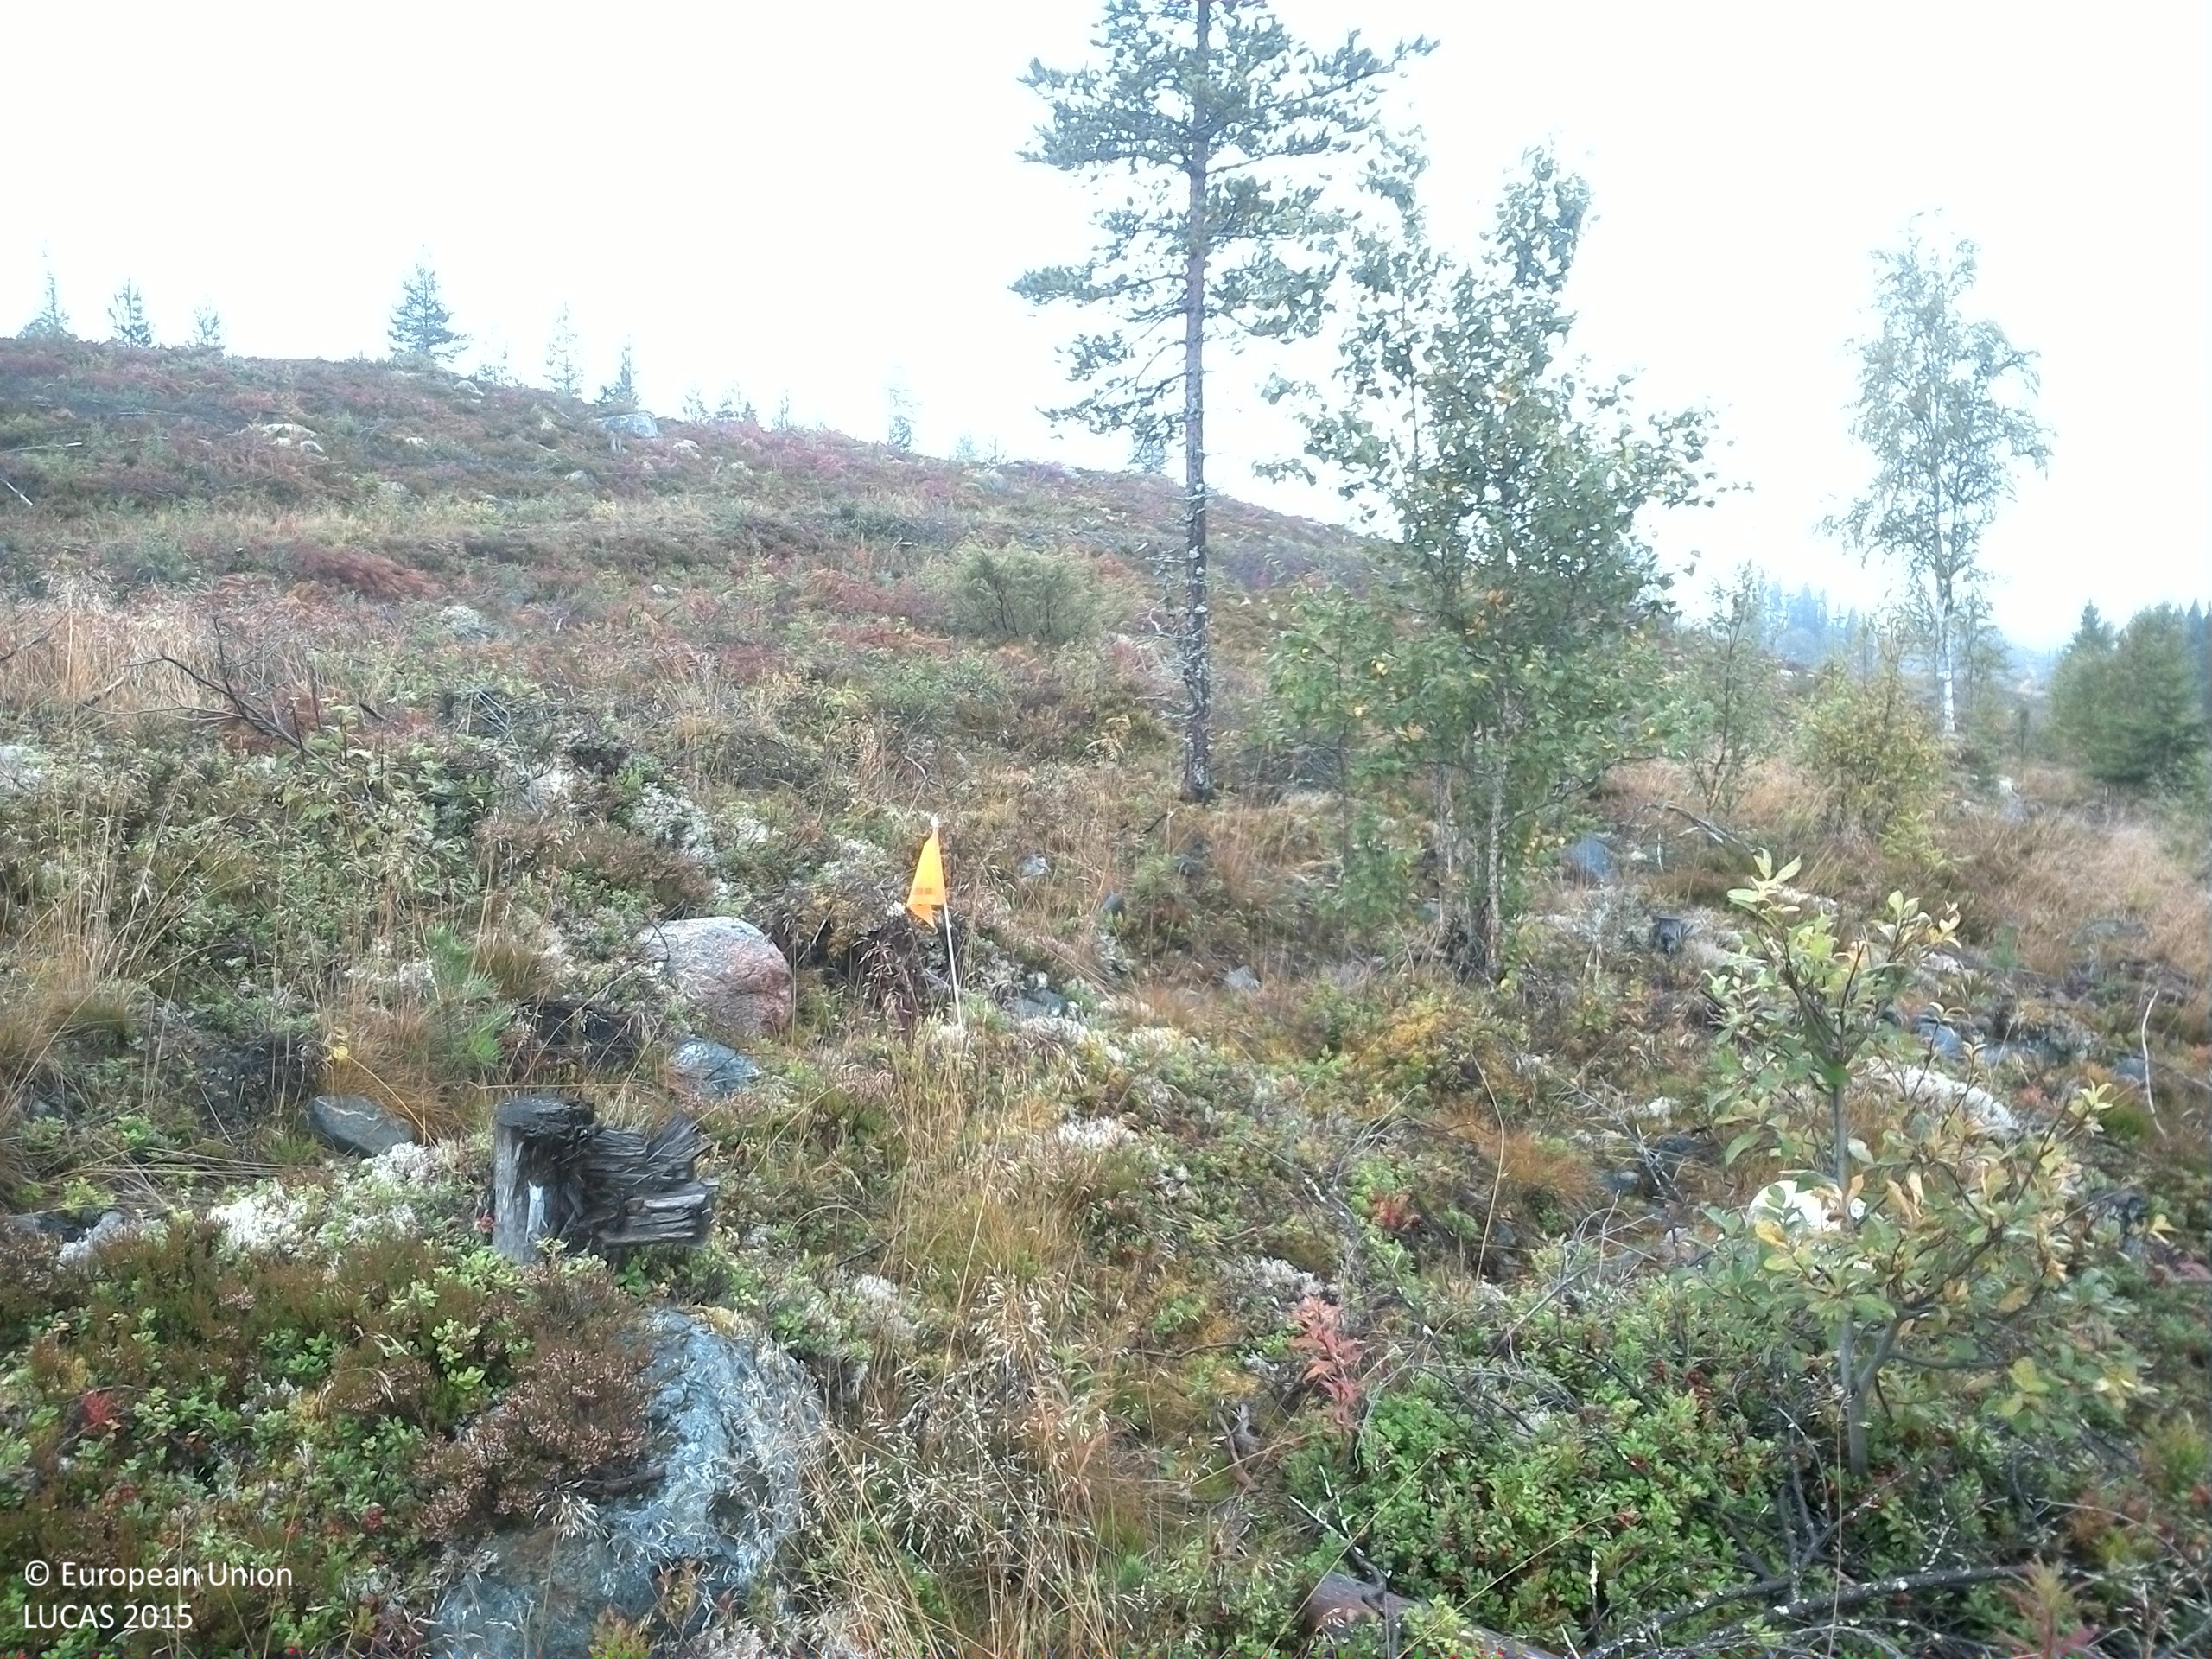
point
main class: Shrubland
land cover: Shrubland with sparse tree cover
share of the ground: > 75 %
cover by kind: shrubs 70 %, lichens and mosses 10 %, consolidated bare surface 10 %, coniferous forest trees 5 %, herbaceous plants 5 %
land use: Forestry
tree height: < 5 m
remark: Clear cut
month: September
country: SE
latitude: 61.6742
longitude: 15.1789
